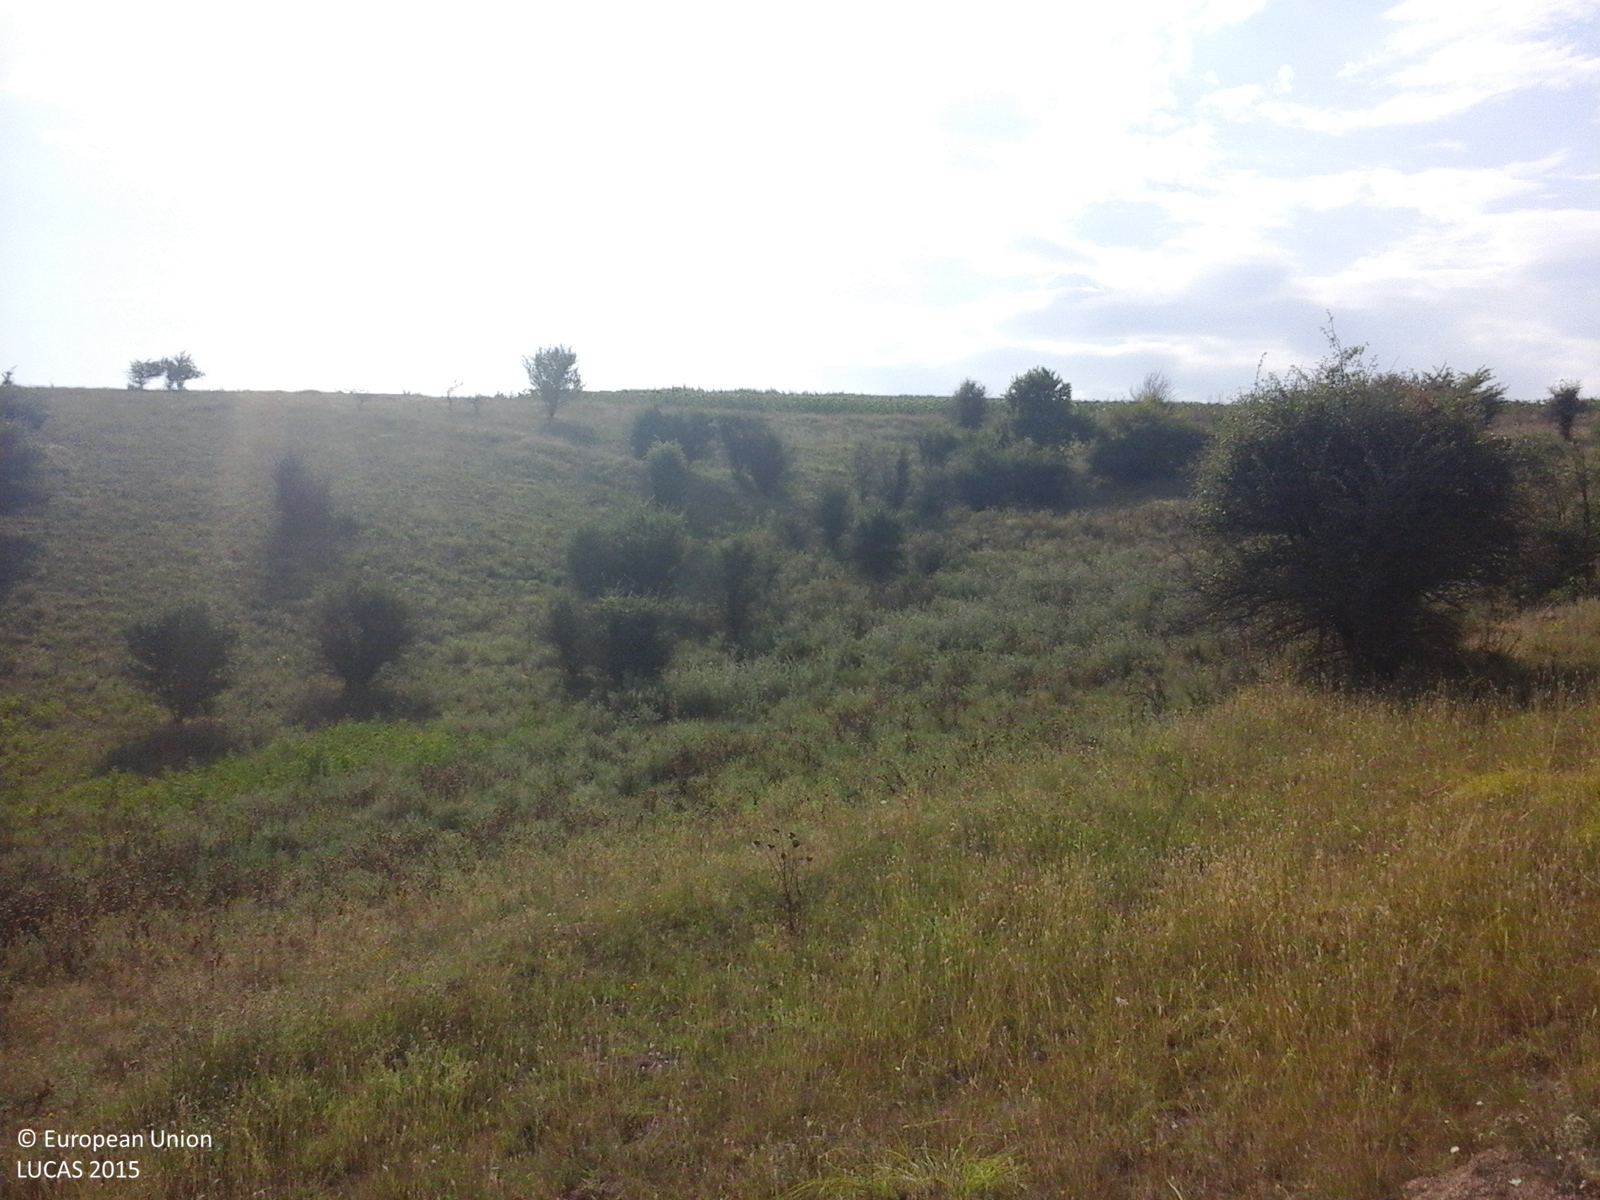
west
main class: Grassland
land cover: Grassland without tree/shrub cover
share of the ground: > 75 %
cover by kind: herbaceous plants 100 %
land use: Agriculture (excluding fallow land and kitchen gardens)
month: August
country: RO
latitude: 44.1755
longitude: 27.9253
